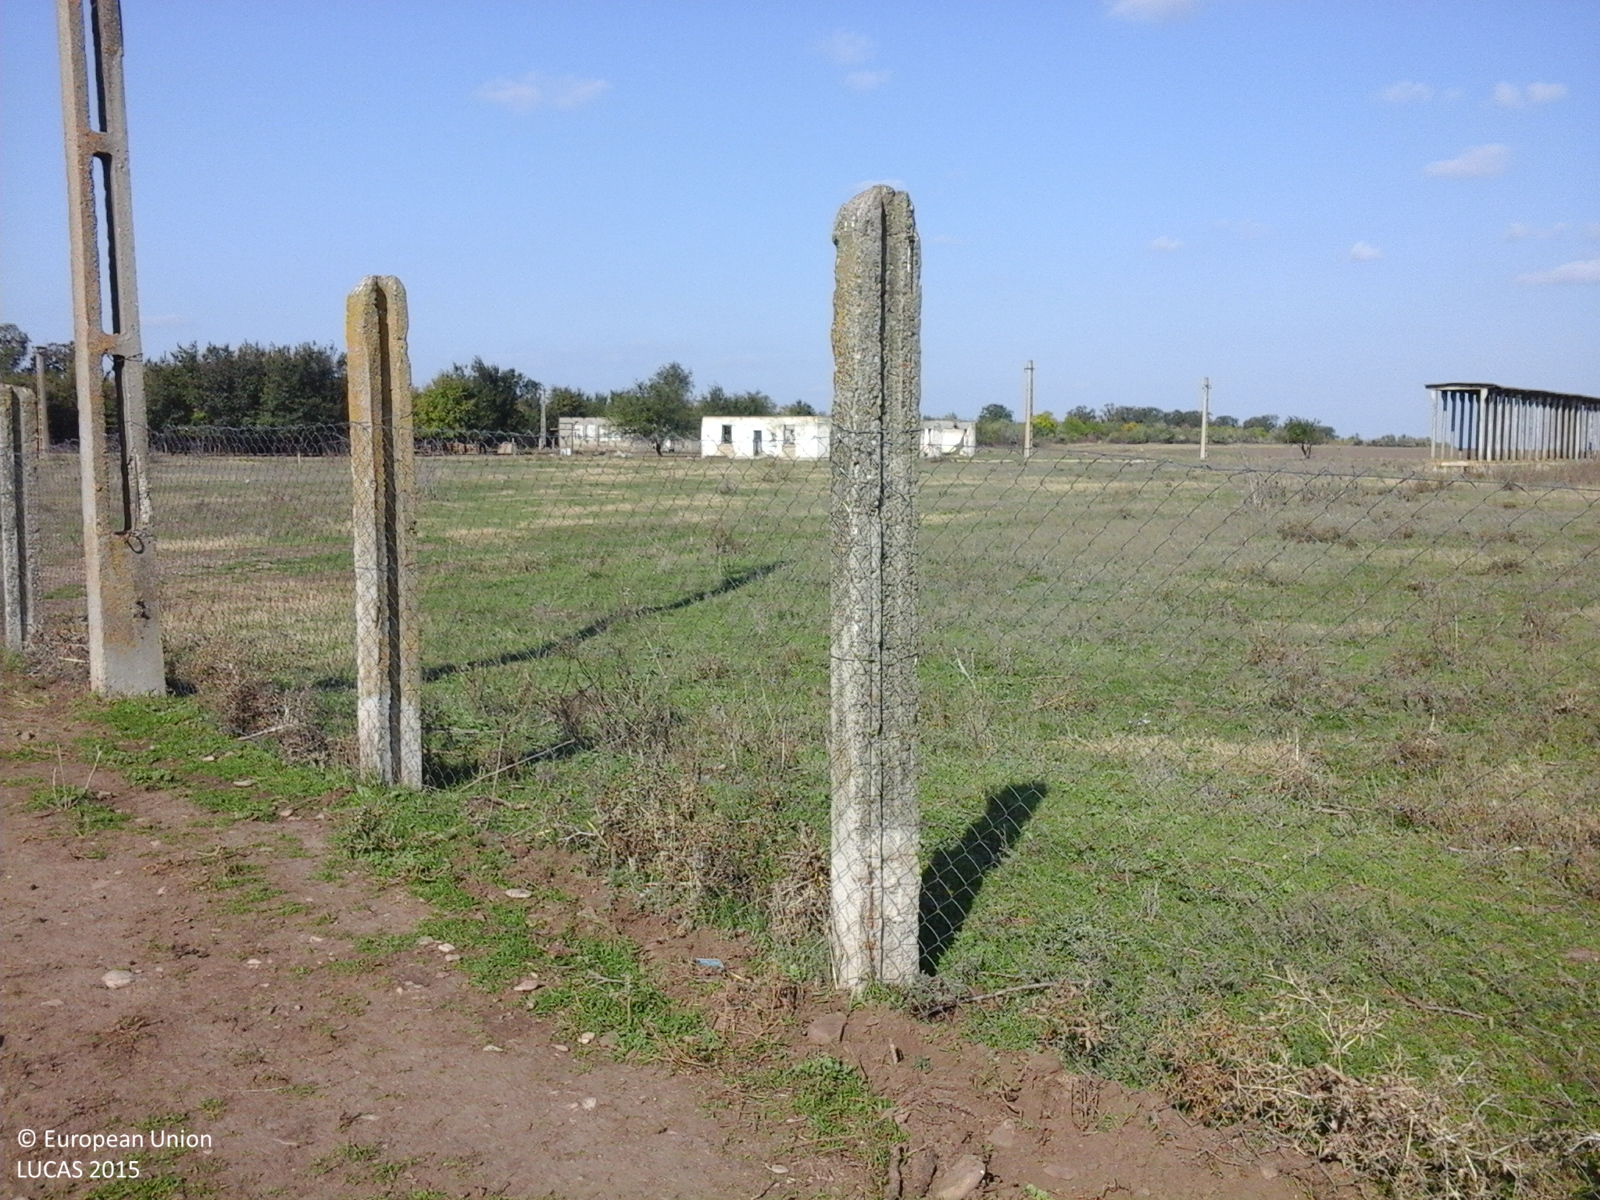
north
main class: Grassland
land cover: Spontaneously vegetated surfaces
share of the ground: > 75 %
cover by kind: herbaceous plants 100 %
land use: Fallow land
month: October
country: RO
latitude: 45.2306
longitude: 27.2494
